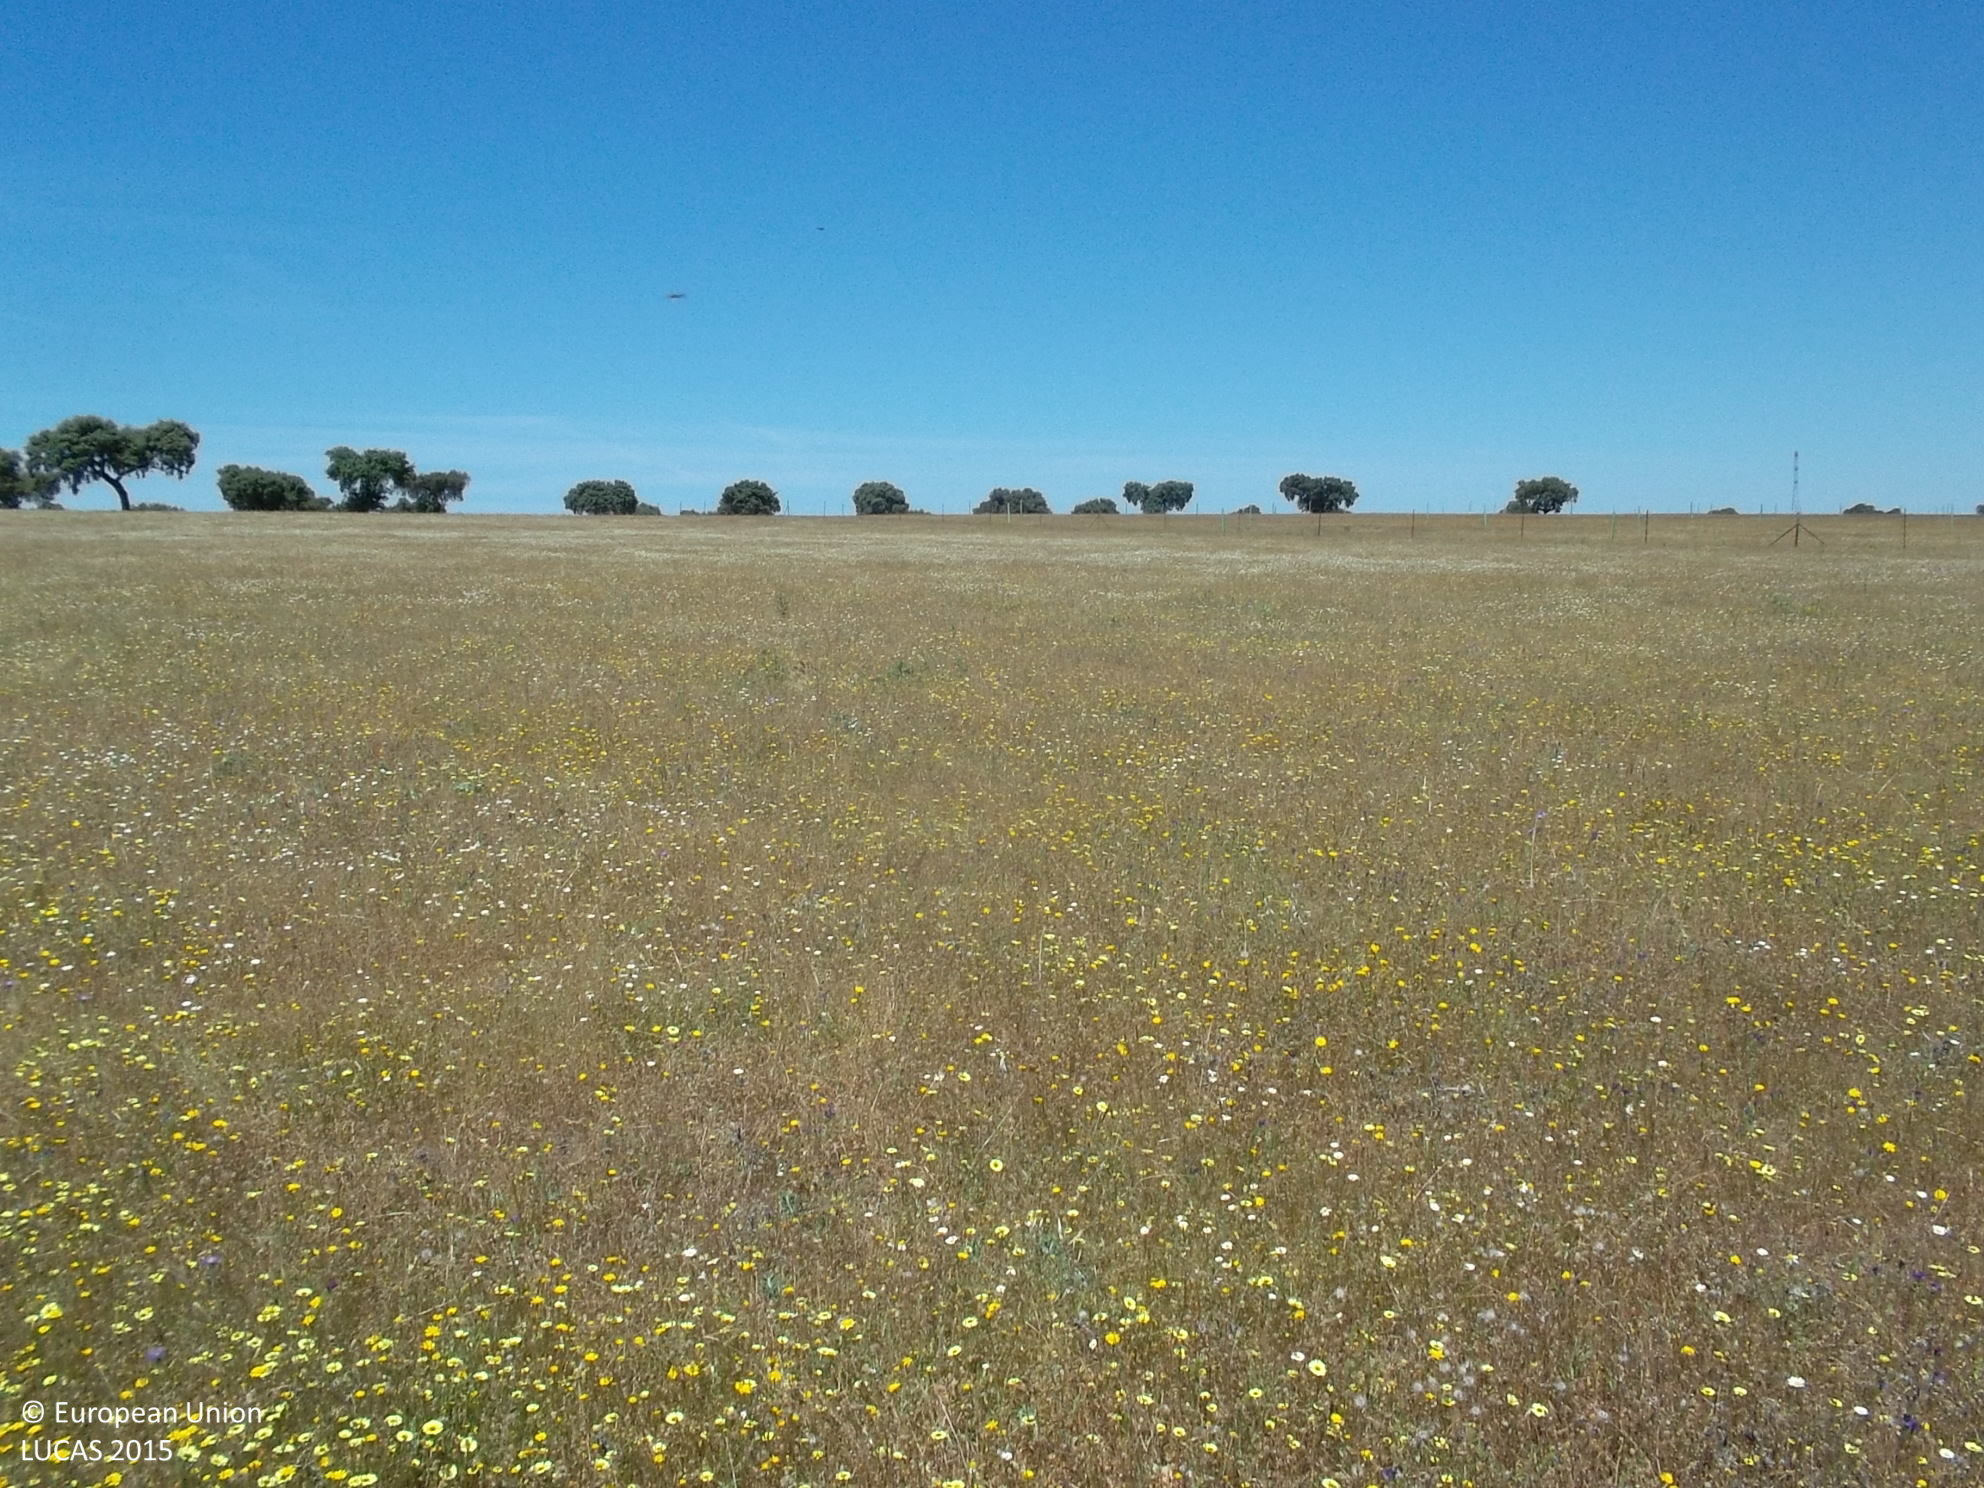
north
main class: Woodland
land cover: Broadleaved woodland
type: broadleaved evergreen forest
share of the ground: 10 - 25 %
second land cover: Spontaneously vegetated surfaces
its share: > 75 %
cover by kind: herbaceous plants 80 %, broadleaved forest trees 20 %
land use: Forestry
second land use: Agriculture (excluding fallow land and kitchen gardens)
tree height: > 5 m
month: May
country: ES
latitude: 38.8764
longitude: -4.4689
